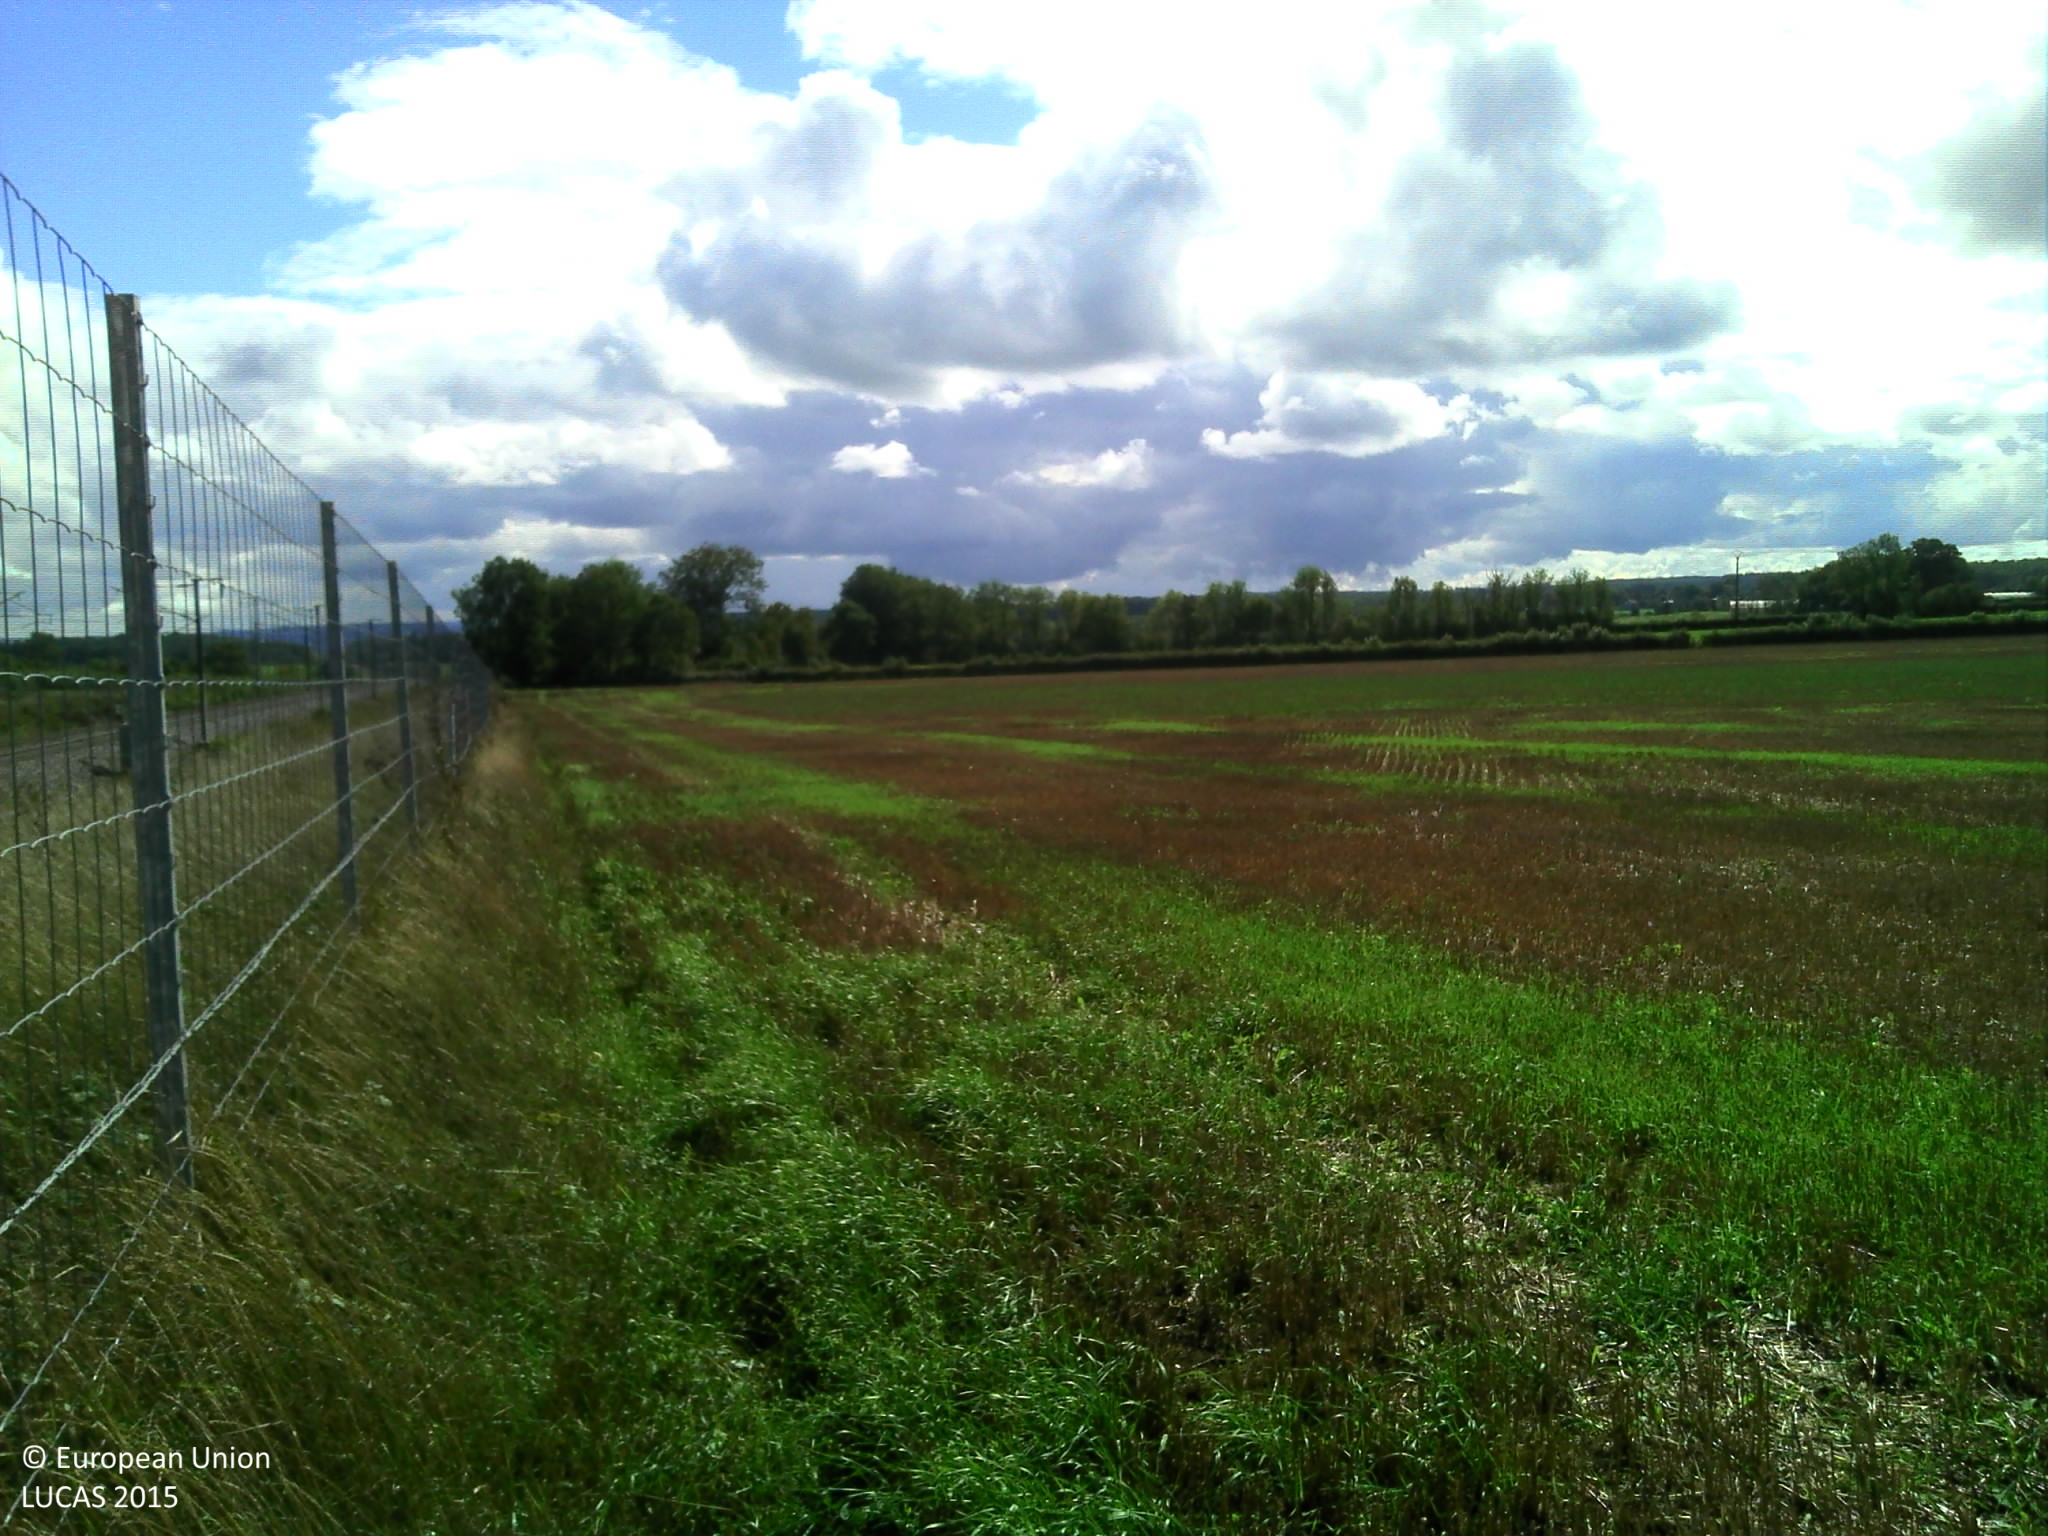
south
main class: Grassland
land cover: Grassland without tree/shrub cover
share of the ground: > 75 %
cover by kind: herbaceous plants 100 %
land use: Railway transport
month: September
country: FR
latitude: 47.2105
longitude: 4.3088
